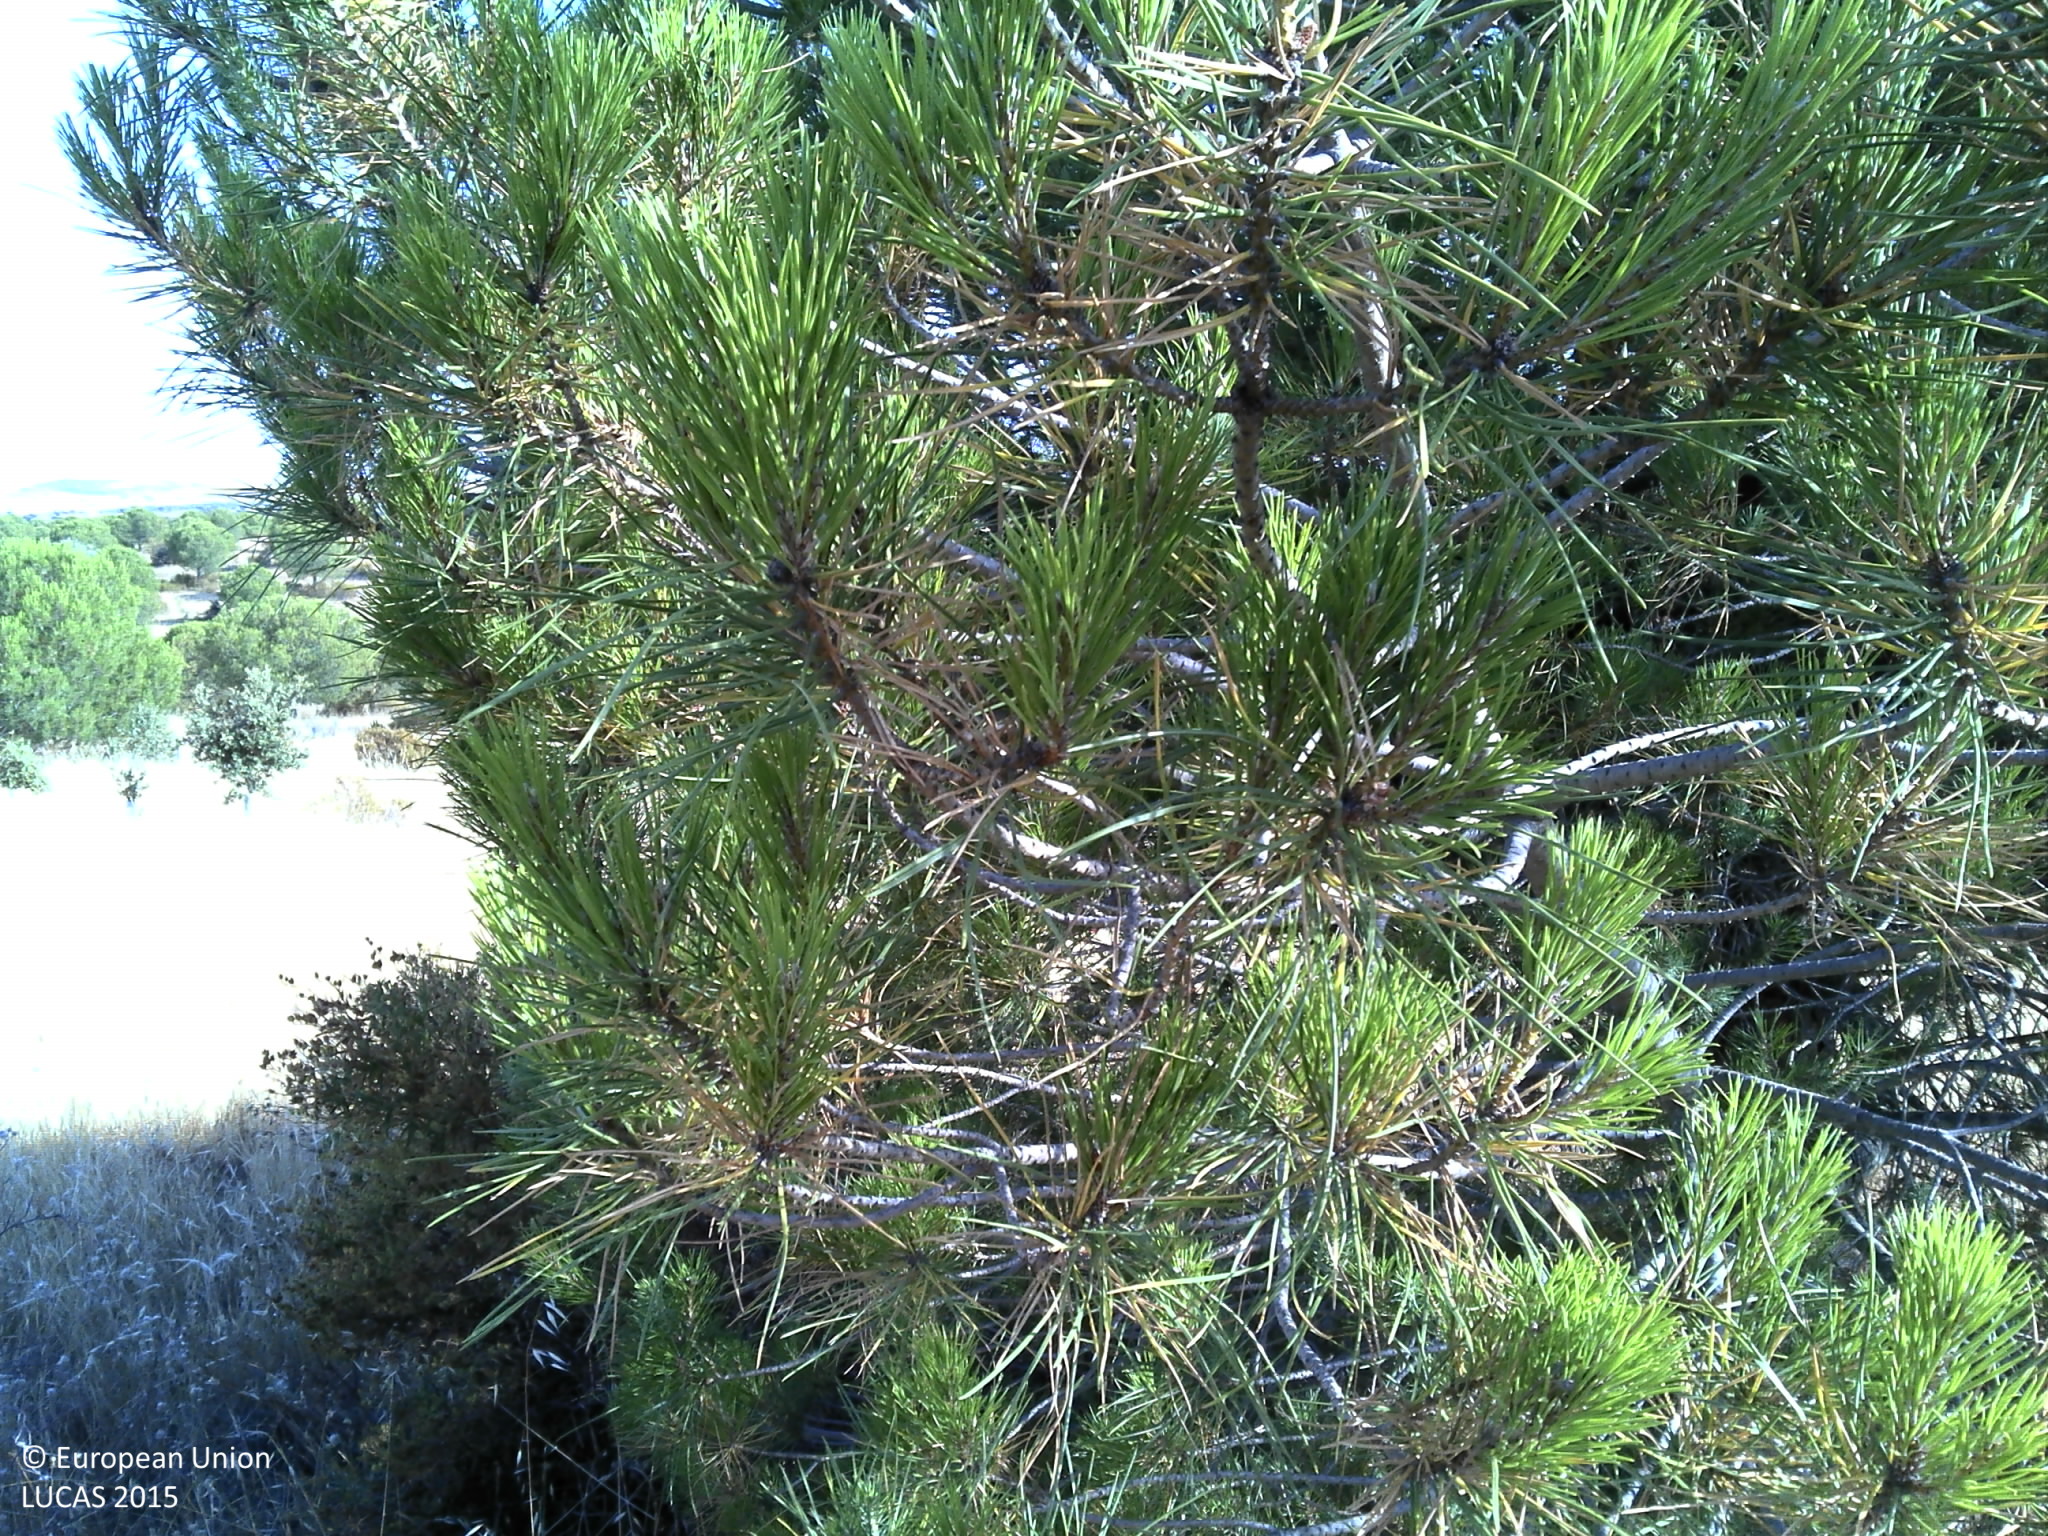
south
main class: Woodland
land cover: Pine dominated coniferous woodland
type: coniferous forest of the mediterranean region
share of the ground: 10 - 25 %
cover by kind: herbaceous plants 65 %, coniferous forest trees 25 %, broadleaved forest trees 5 %, shrubs 5 %
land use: Forestry
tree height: < 5 m
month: June
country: PT
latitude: 37.6160
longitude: -7.5617
